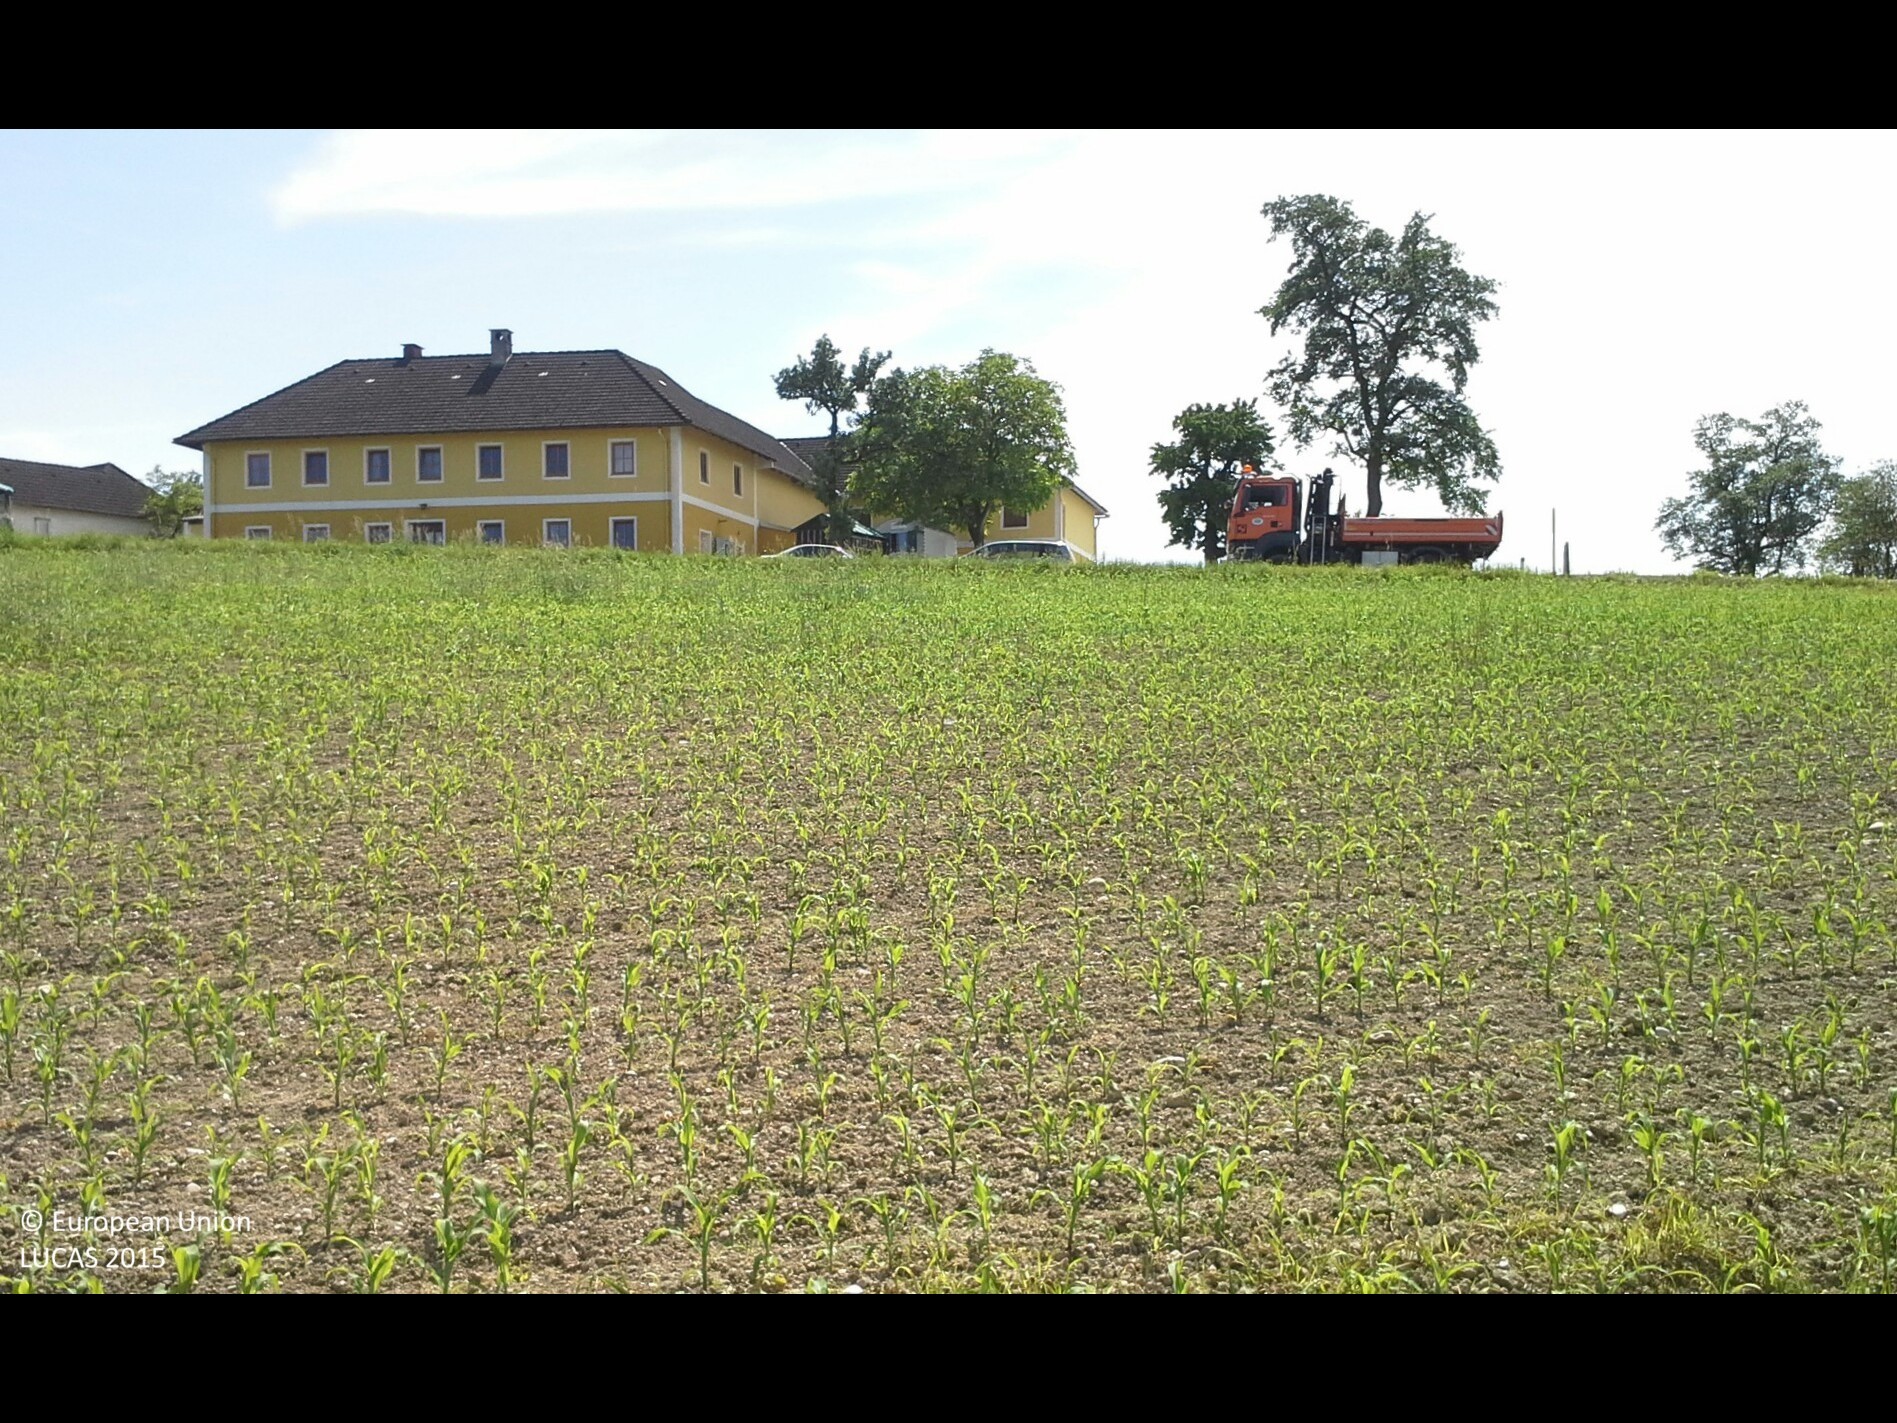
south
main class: Grassland
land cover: Grassland without tree/shrub cover
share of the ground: > 75 %
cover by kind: herbaceous plants 100 %
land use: Agriculture (excluding fallow land and kitchen gardens)
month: June
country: AT
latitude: 48.1360
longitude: 14.8249
